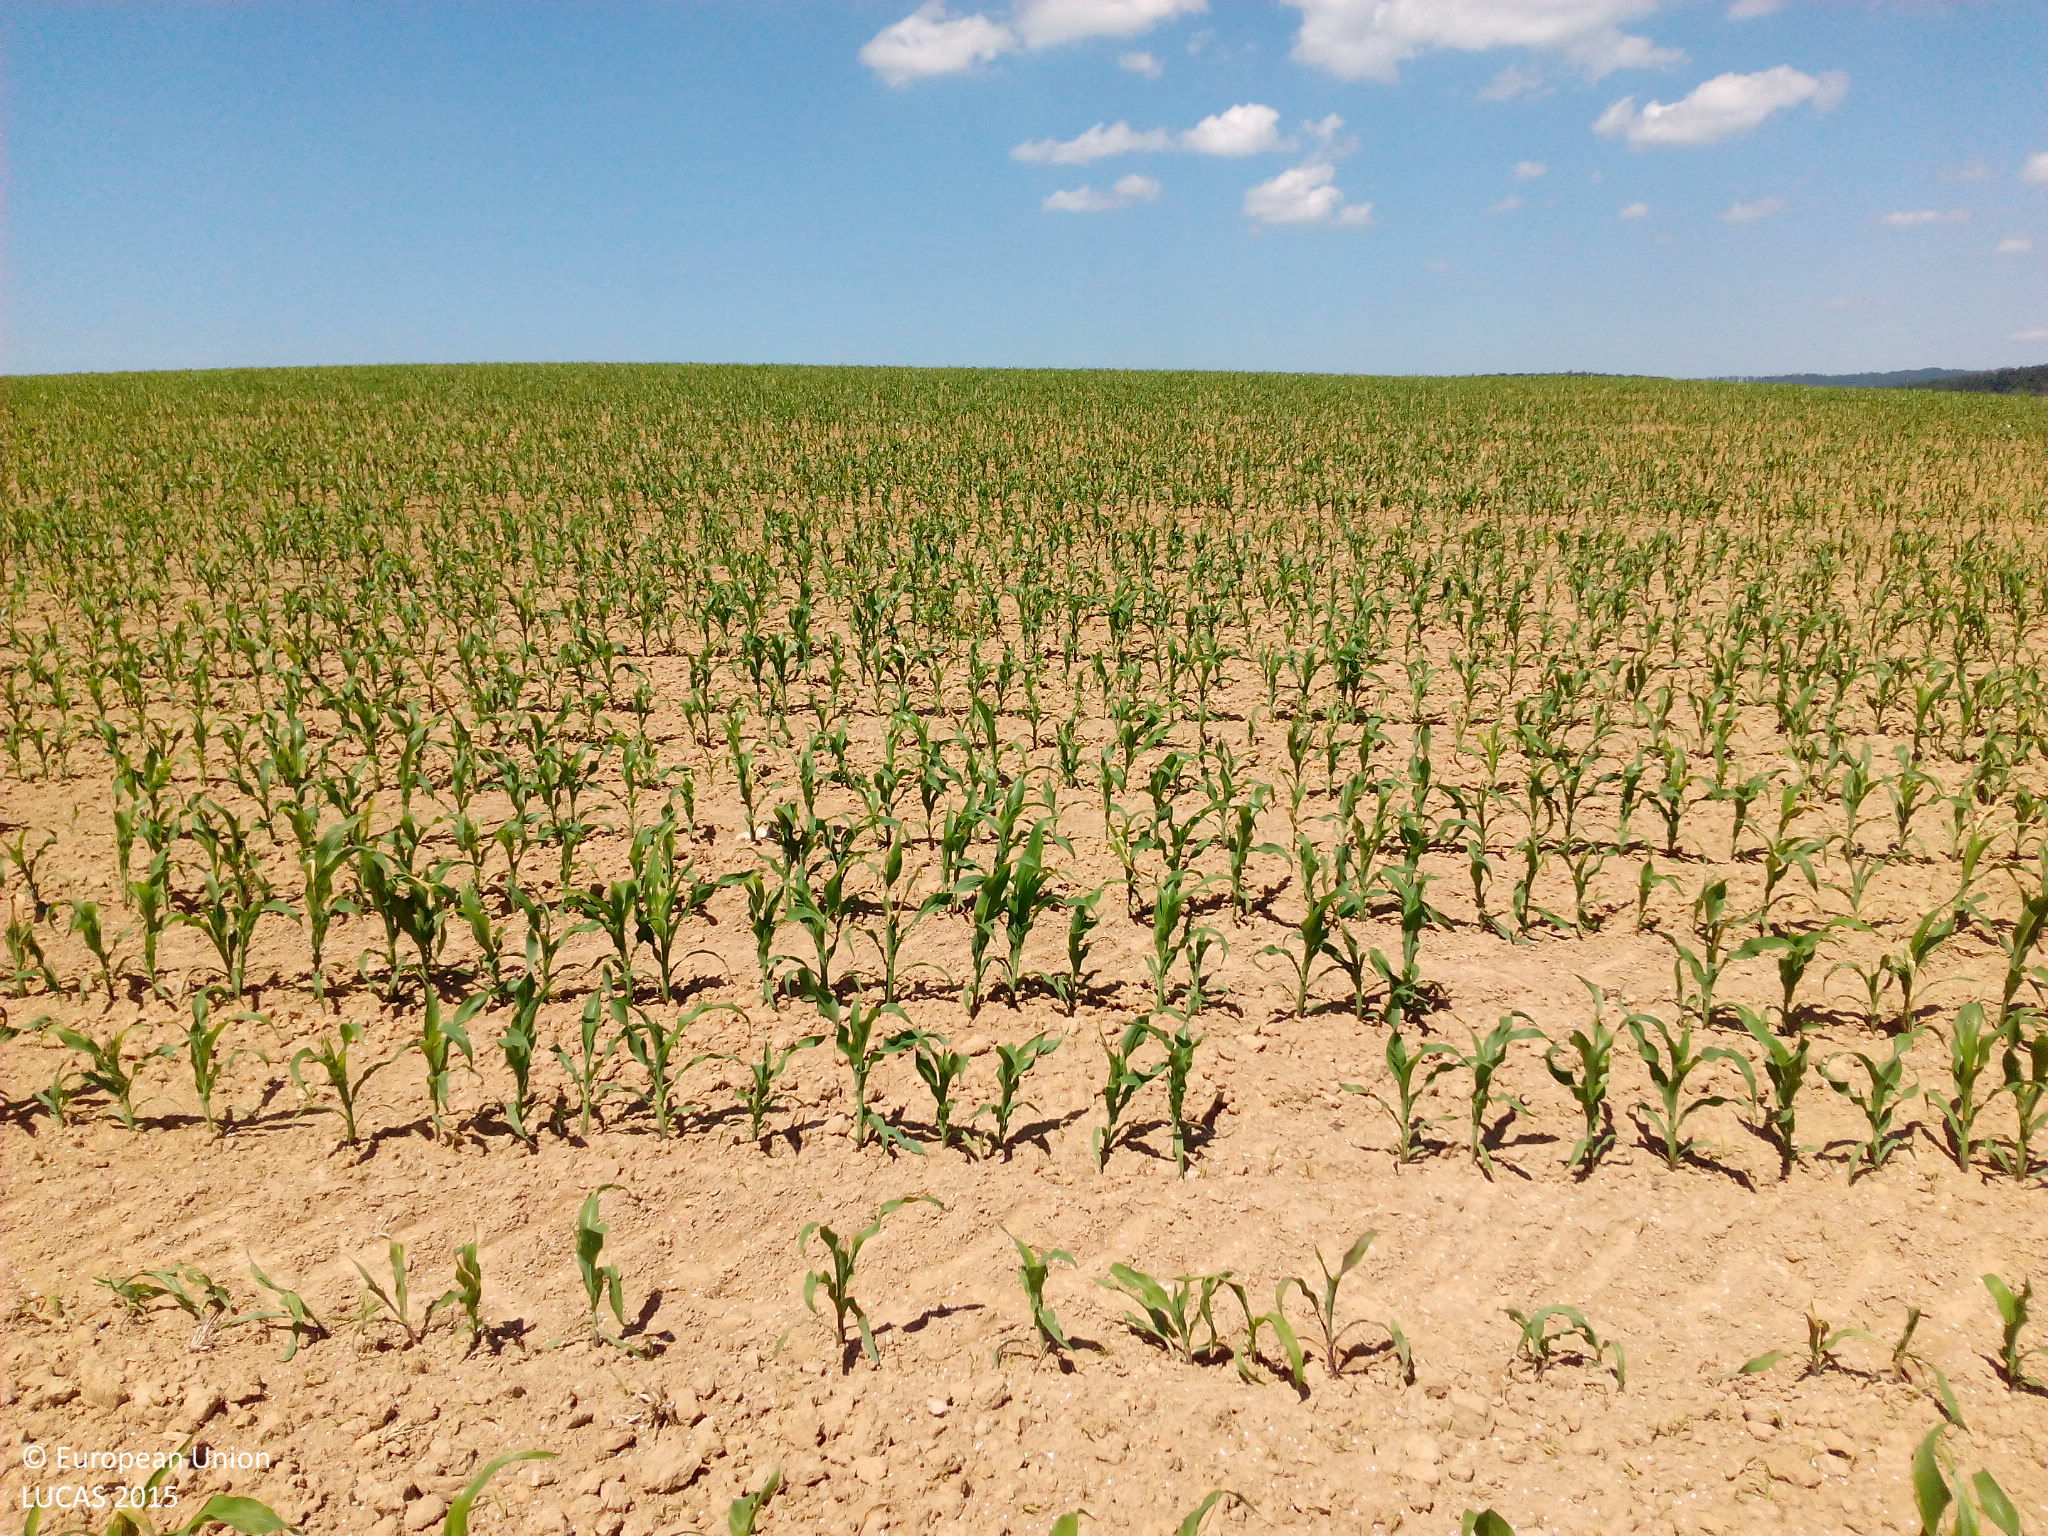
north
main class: Cropland
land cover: Maize
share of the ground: 10 - 25 %
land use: Agriculture (excluding fallow land and kitchen gardens)
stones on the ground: < 10 %
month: June
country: DE
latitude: 48.9597
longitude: 9.4130
